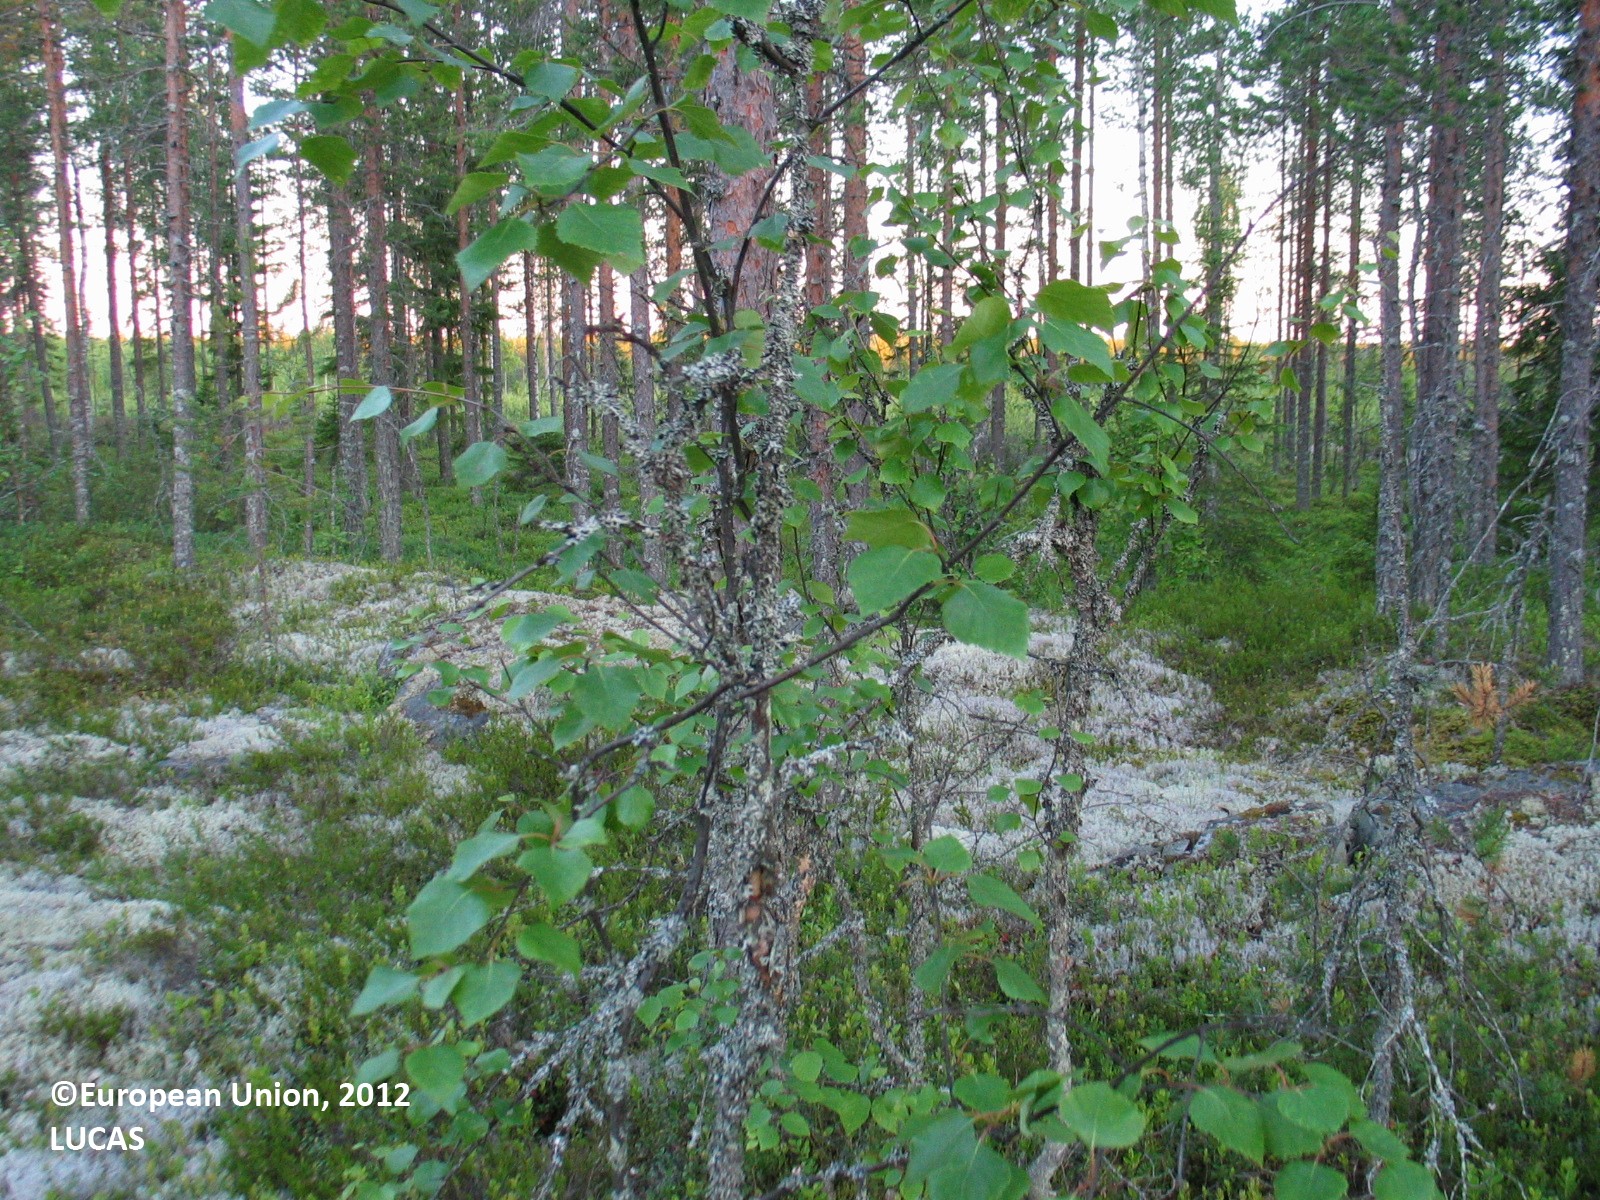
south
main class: Woodland
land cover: Pine dominated coniferous woodland
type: boreal forest
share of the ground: 10 - 25 %
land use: Forestry
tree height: > 5 m
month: July
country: FI
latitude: 64.7695
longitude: 26.6627
